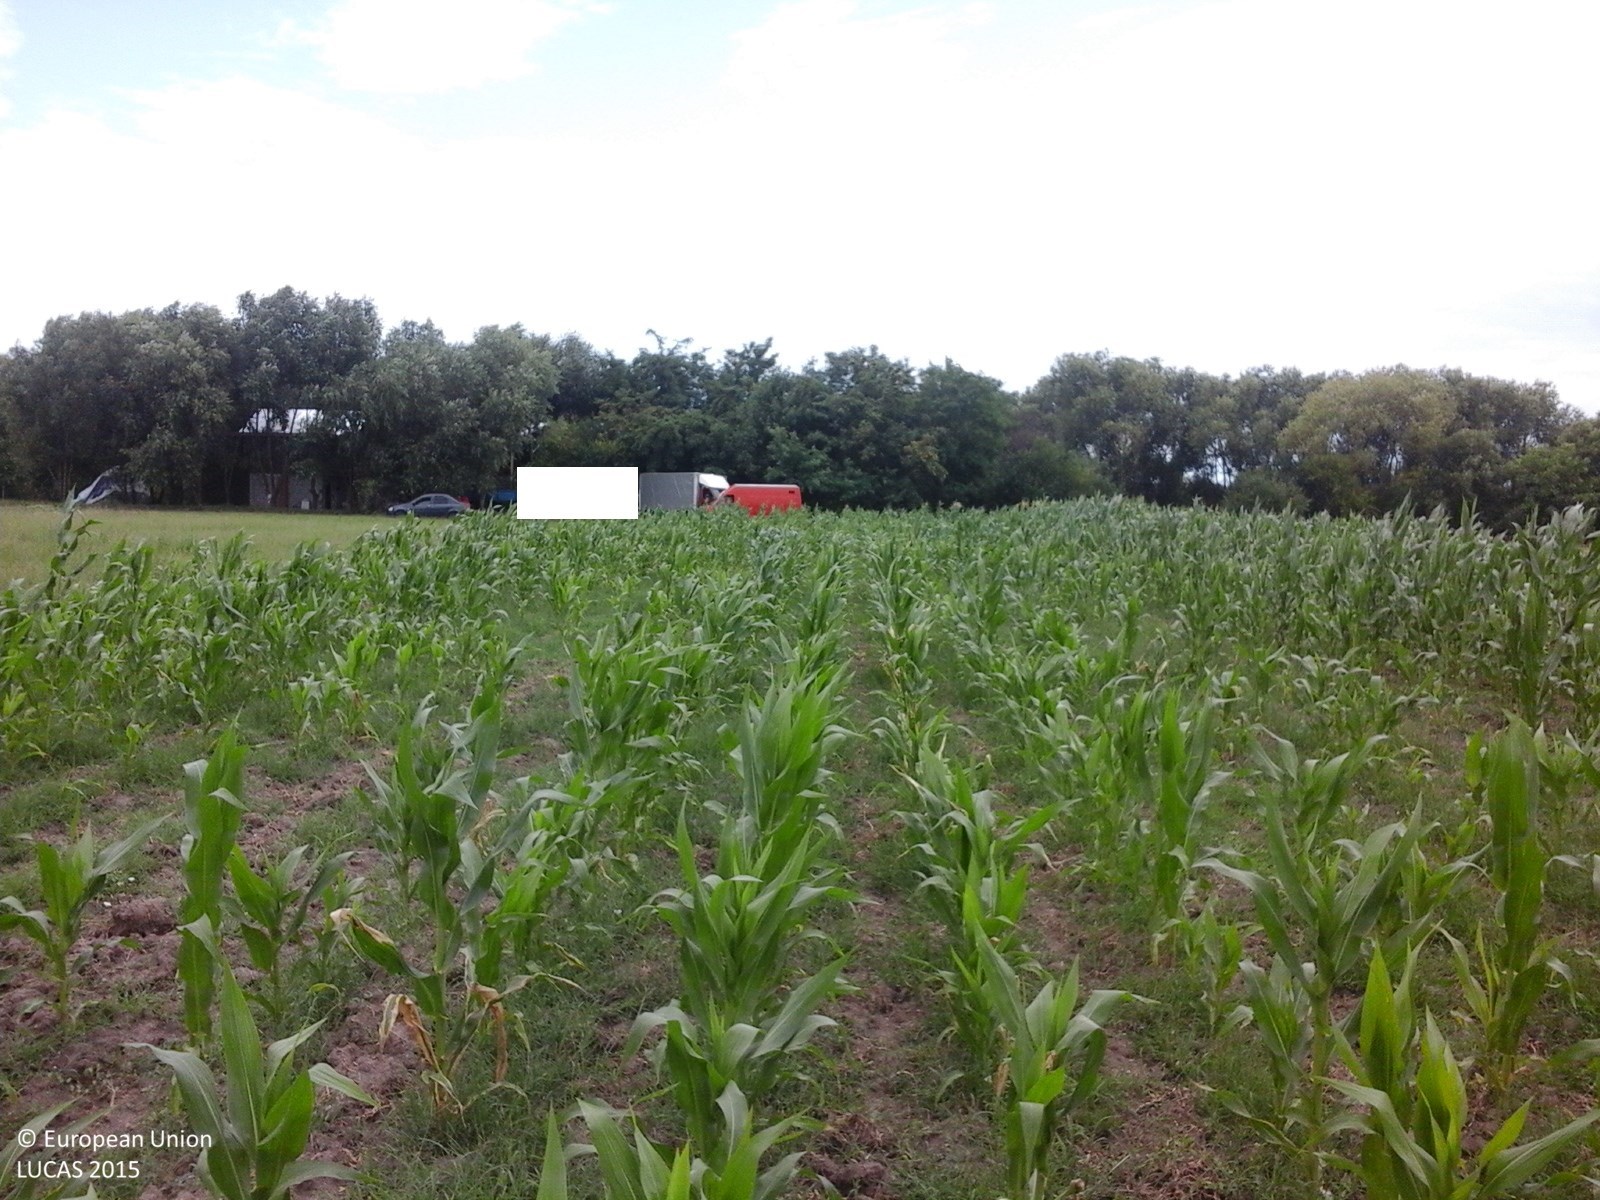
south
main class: Cropland
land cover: Maize
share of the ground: 50 - 75 %
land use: Agriculture (excluding fallow land and kitchen gardens)
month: July
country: RO
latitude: 44.3989
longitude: 25.5474
